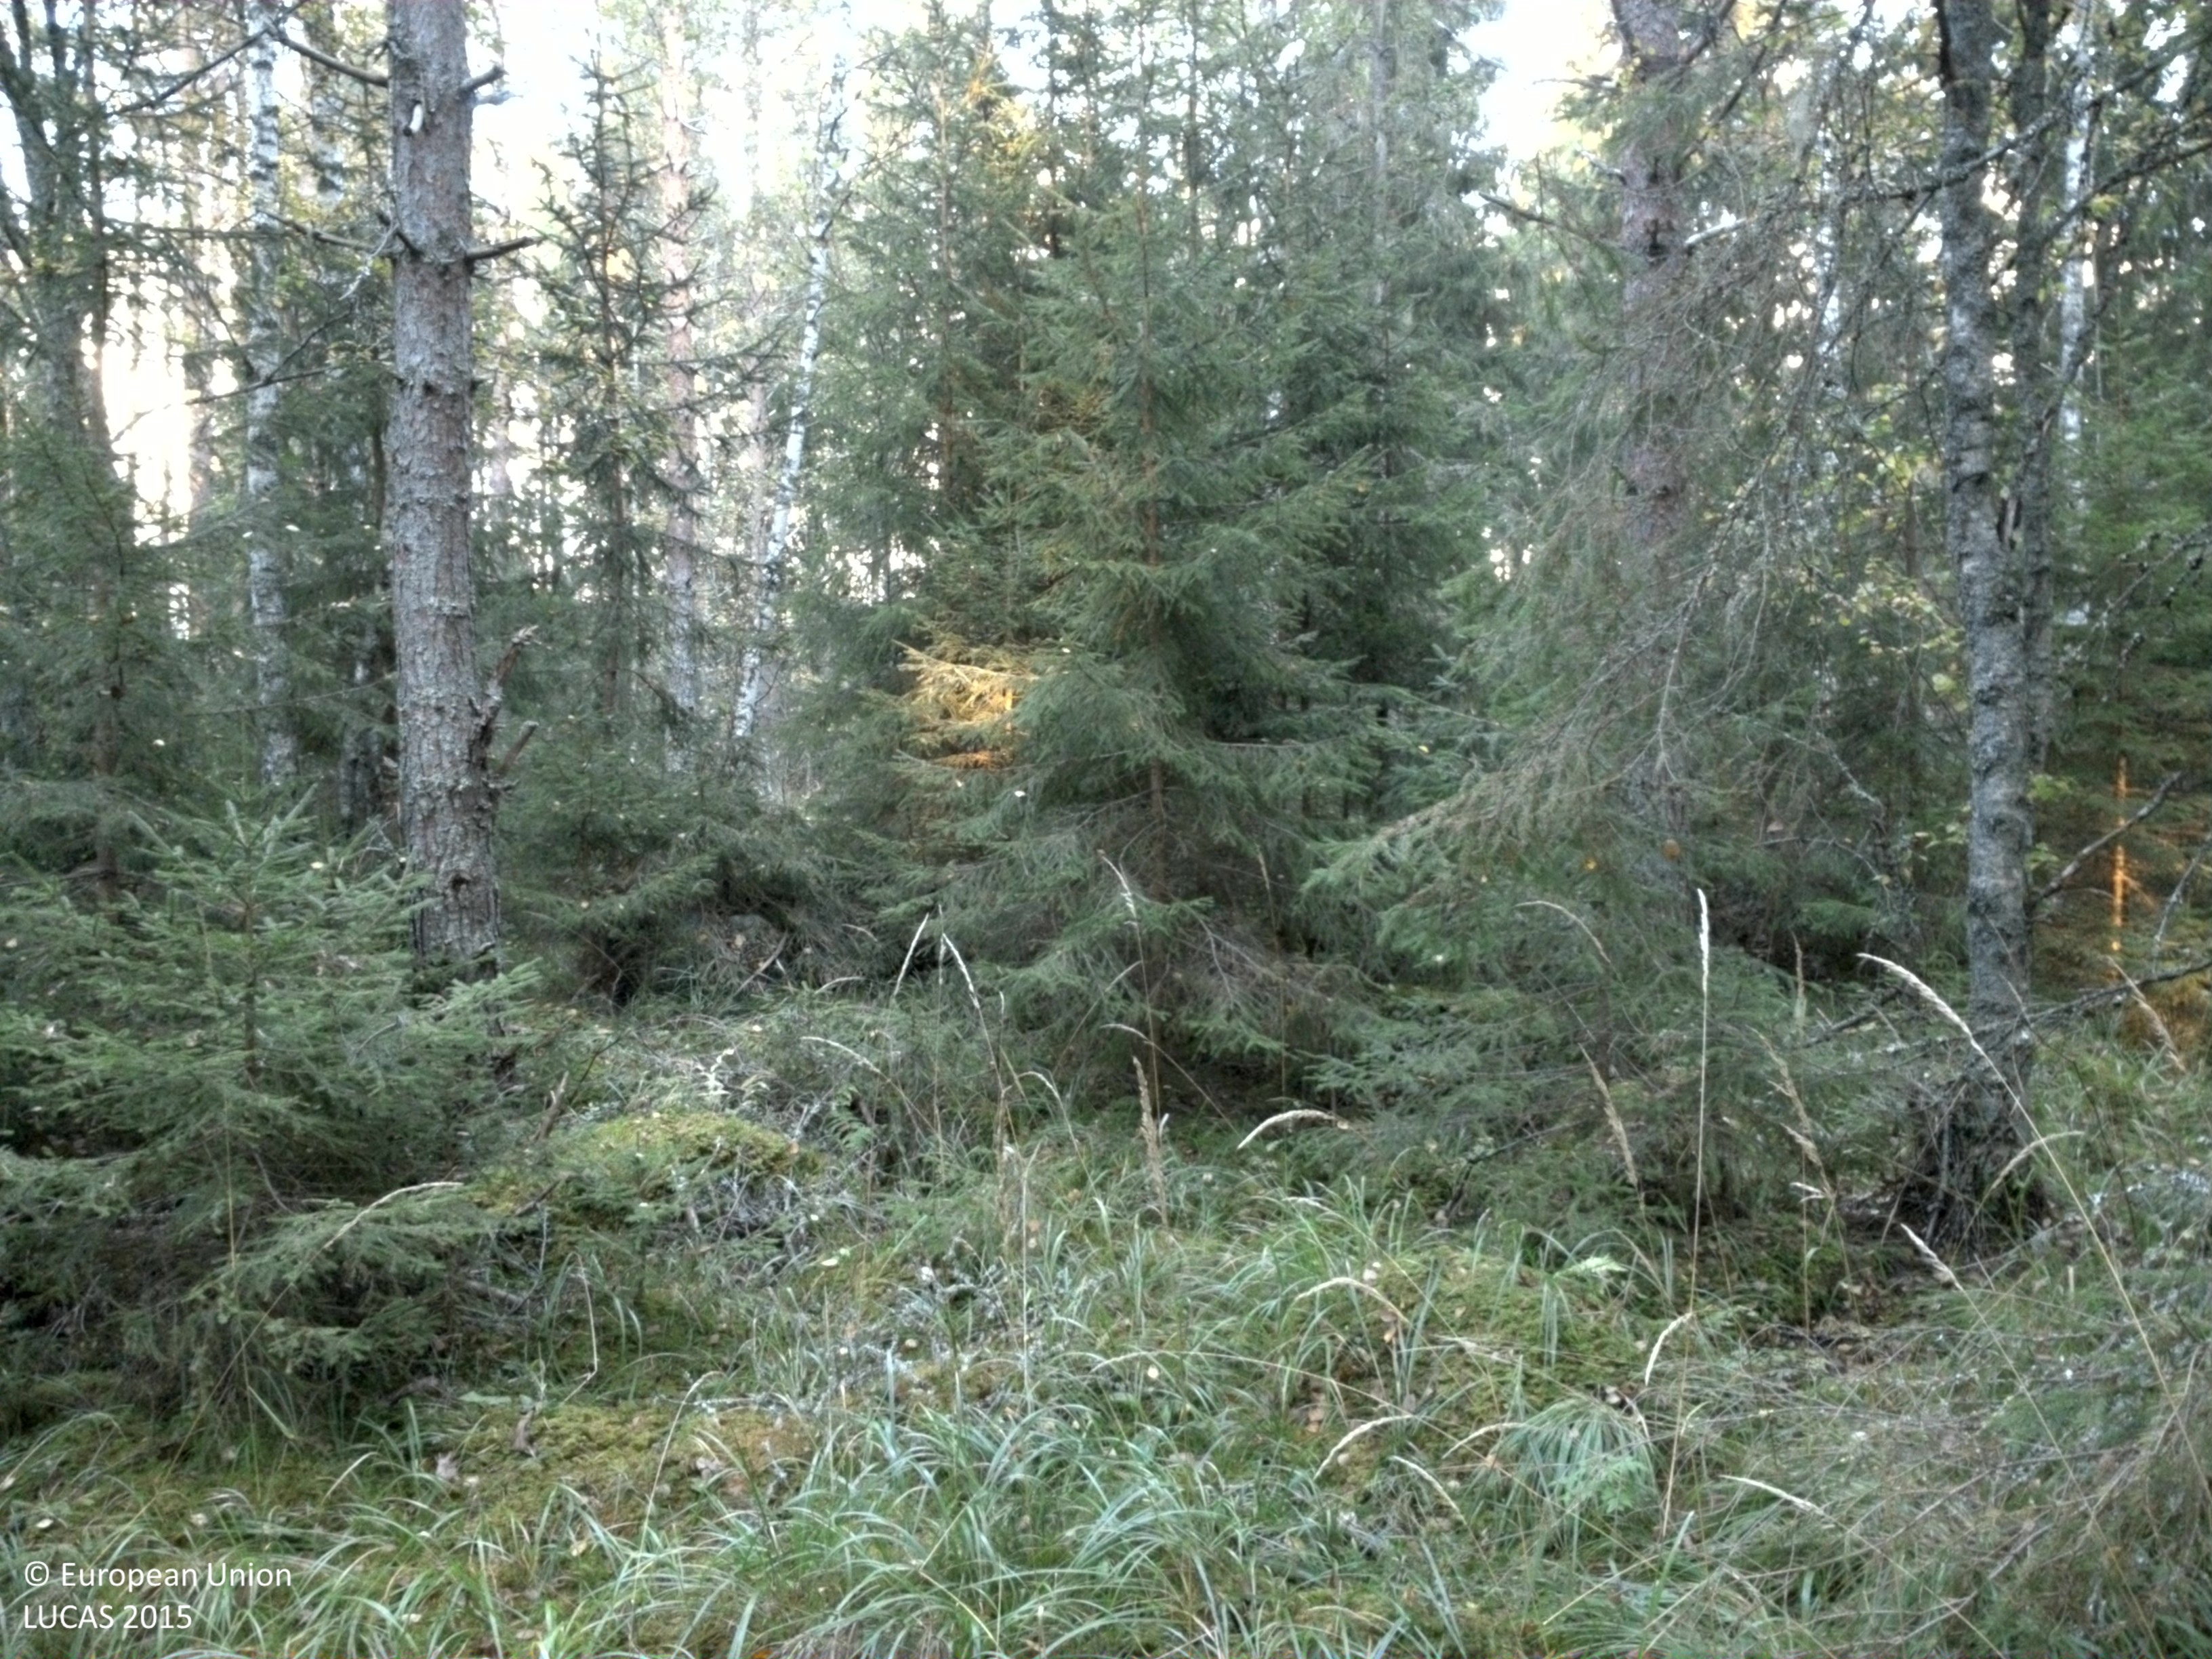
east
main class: Woodland
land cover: Spruce dominated coniferous woodland
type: boreal forest
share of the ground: > 75 %
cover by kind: coniferous forest trees 70 %, lichens and mosses 25 %, broadleaved forest trees 5 %
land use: Forestry
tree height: > 5 m
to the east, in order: Spruce dominated coniferous woodland; Pine dominated mixed woodland; Spruce dominated mixed woodland; Spruce dominated coniferous woodland; Broadleaved woodland; Tracks; Broadleaved woodland; Spruce dominated mixed woodland
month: September
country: SE
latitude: 60.0939
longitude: 16.6975
